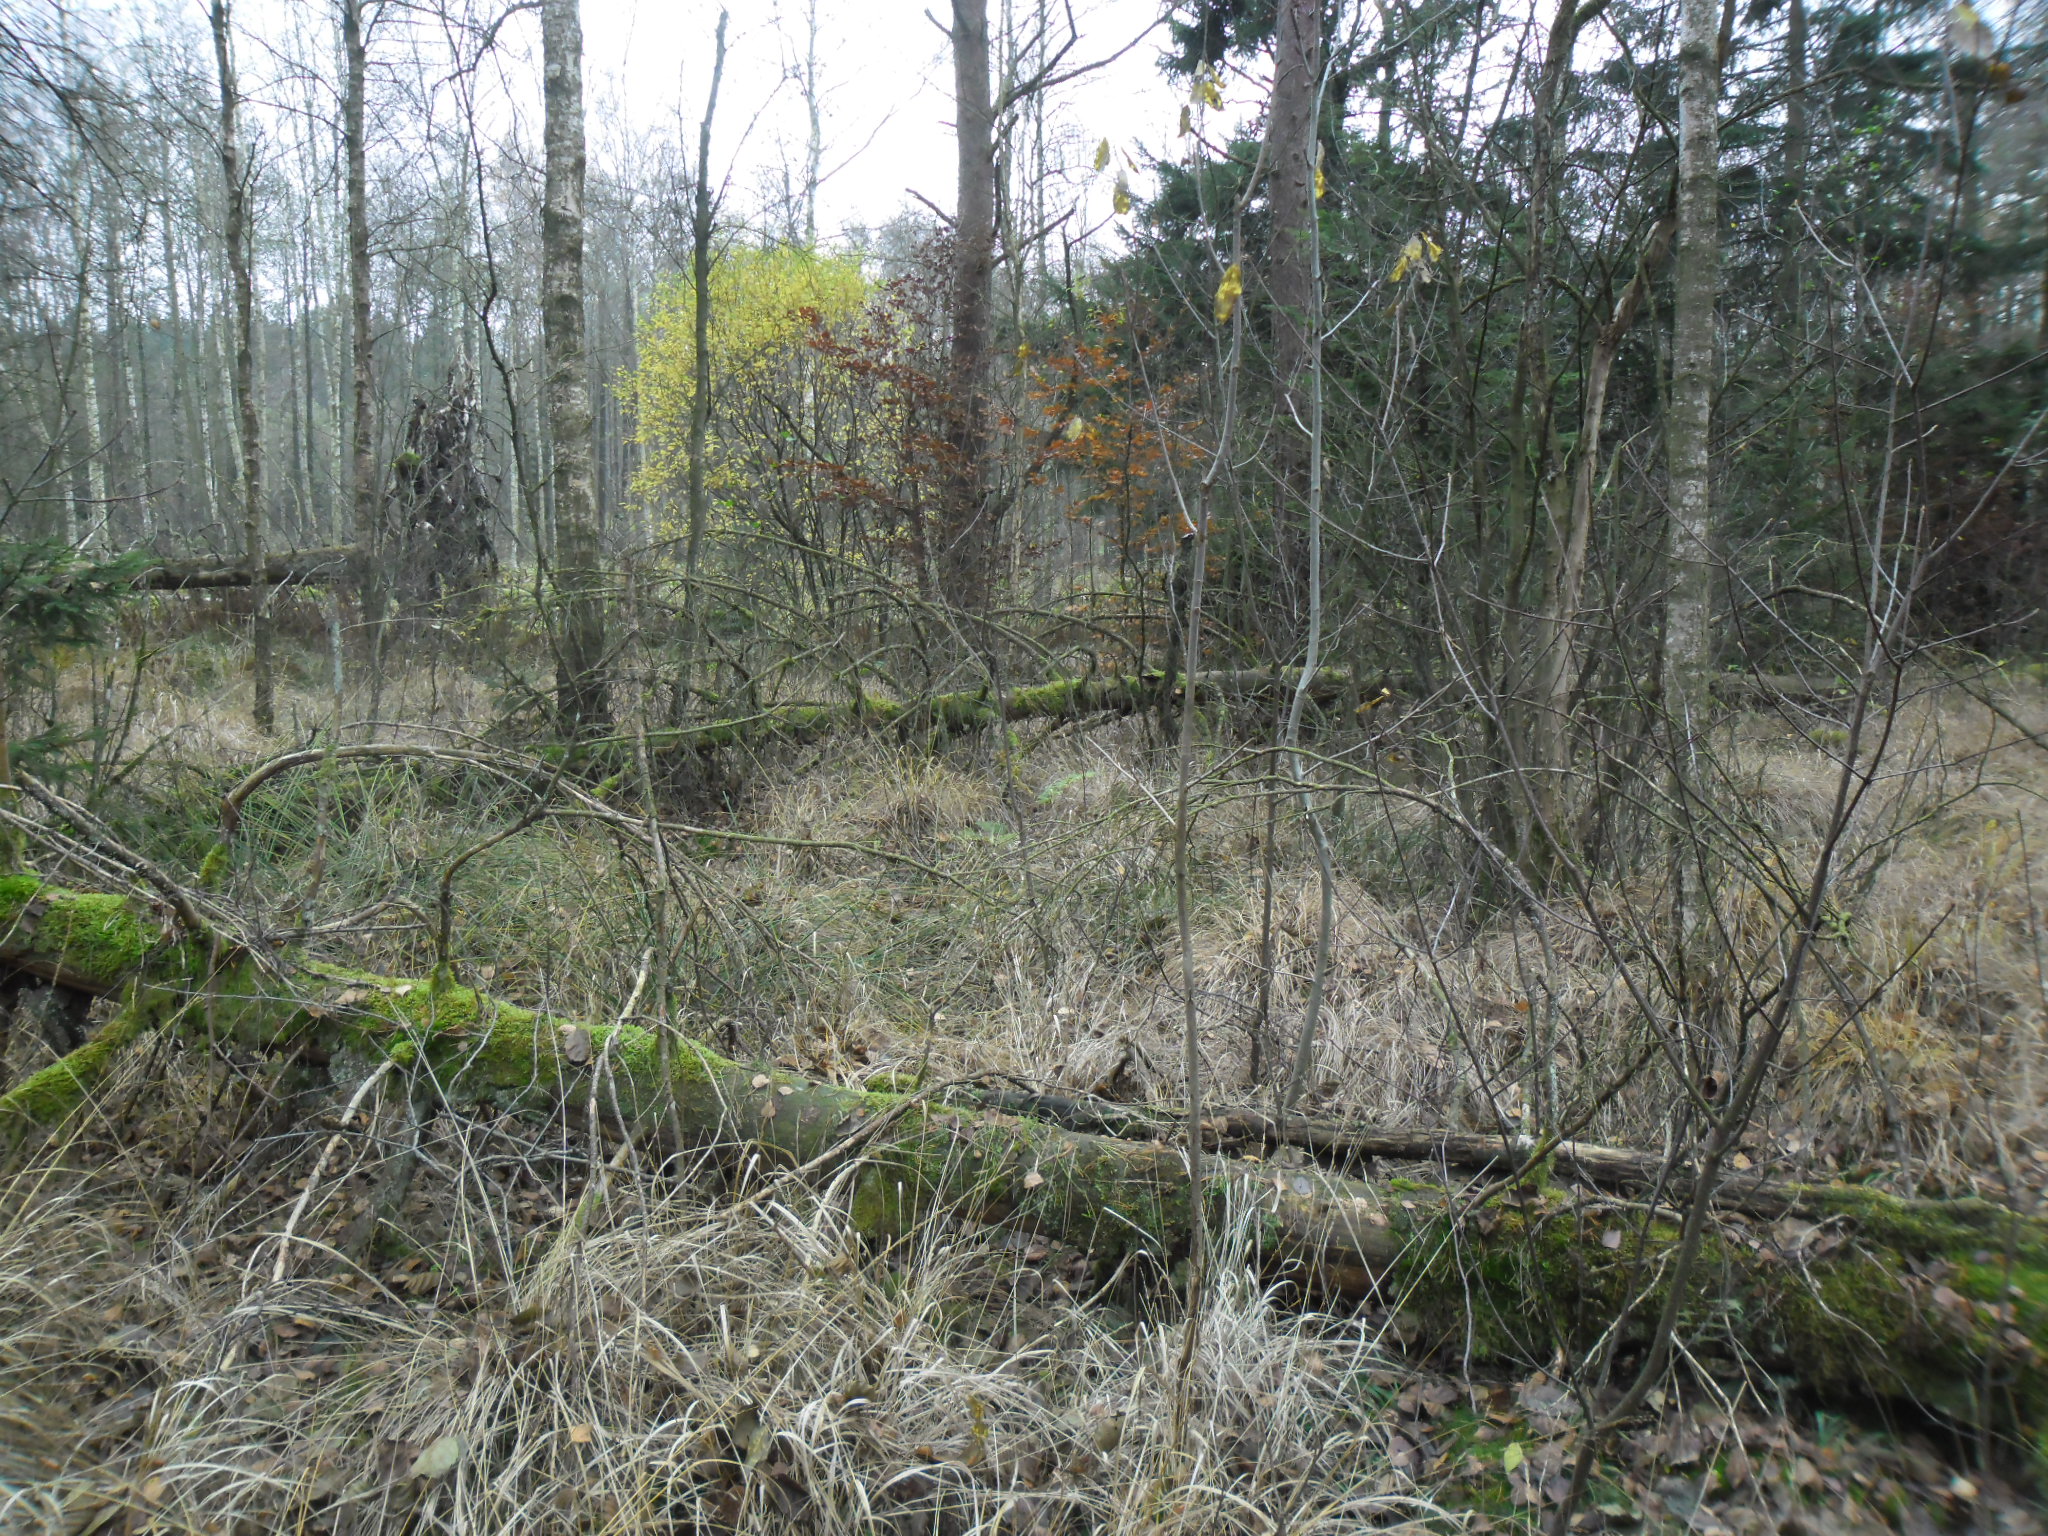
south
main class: Woodland
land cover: Other mixed woodland
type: boreal forest
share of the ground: > 75 %
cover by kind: broadleaved forest trees 60 %, coniferous forest trees 20 %, herbaceous plants 20 %
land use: Forestry
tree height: > 5 m
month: November
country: SE
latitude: 56.2939
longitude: 13.1157
